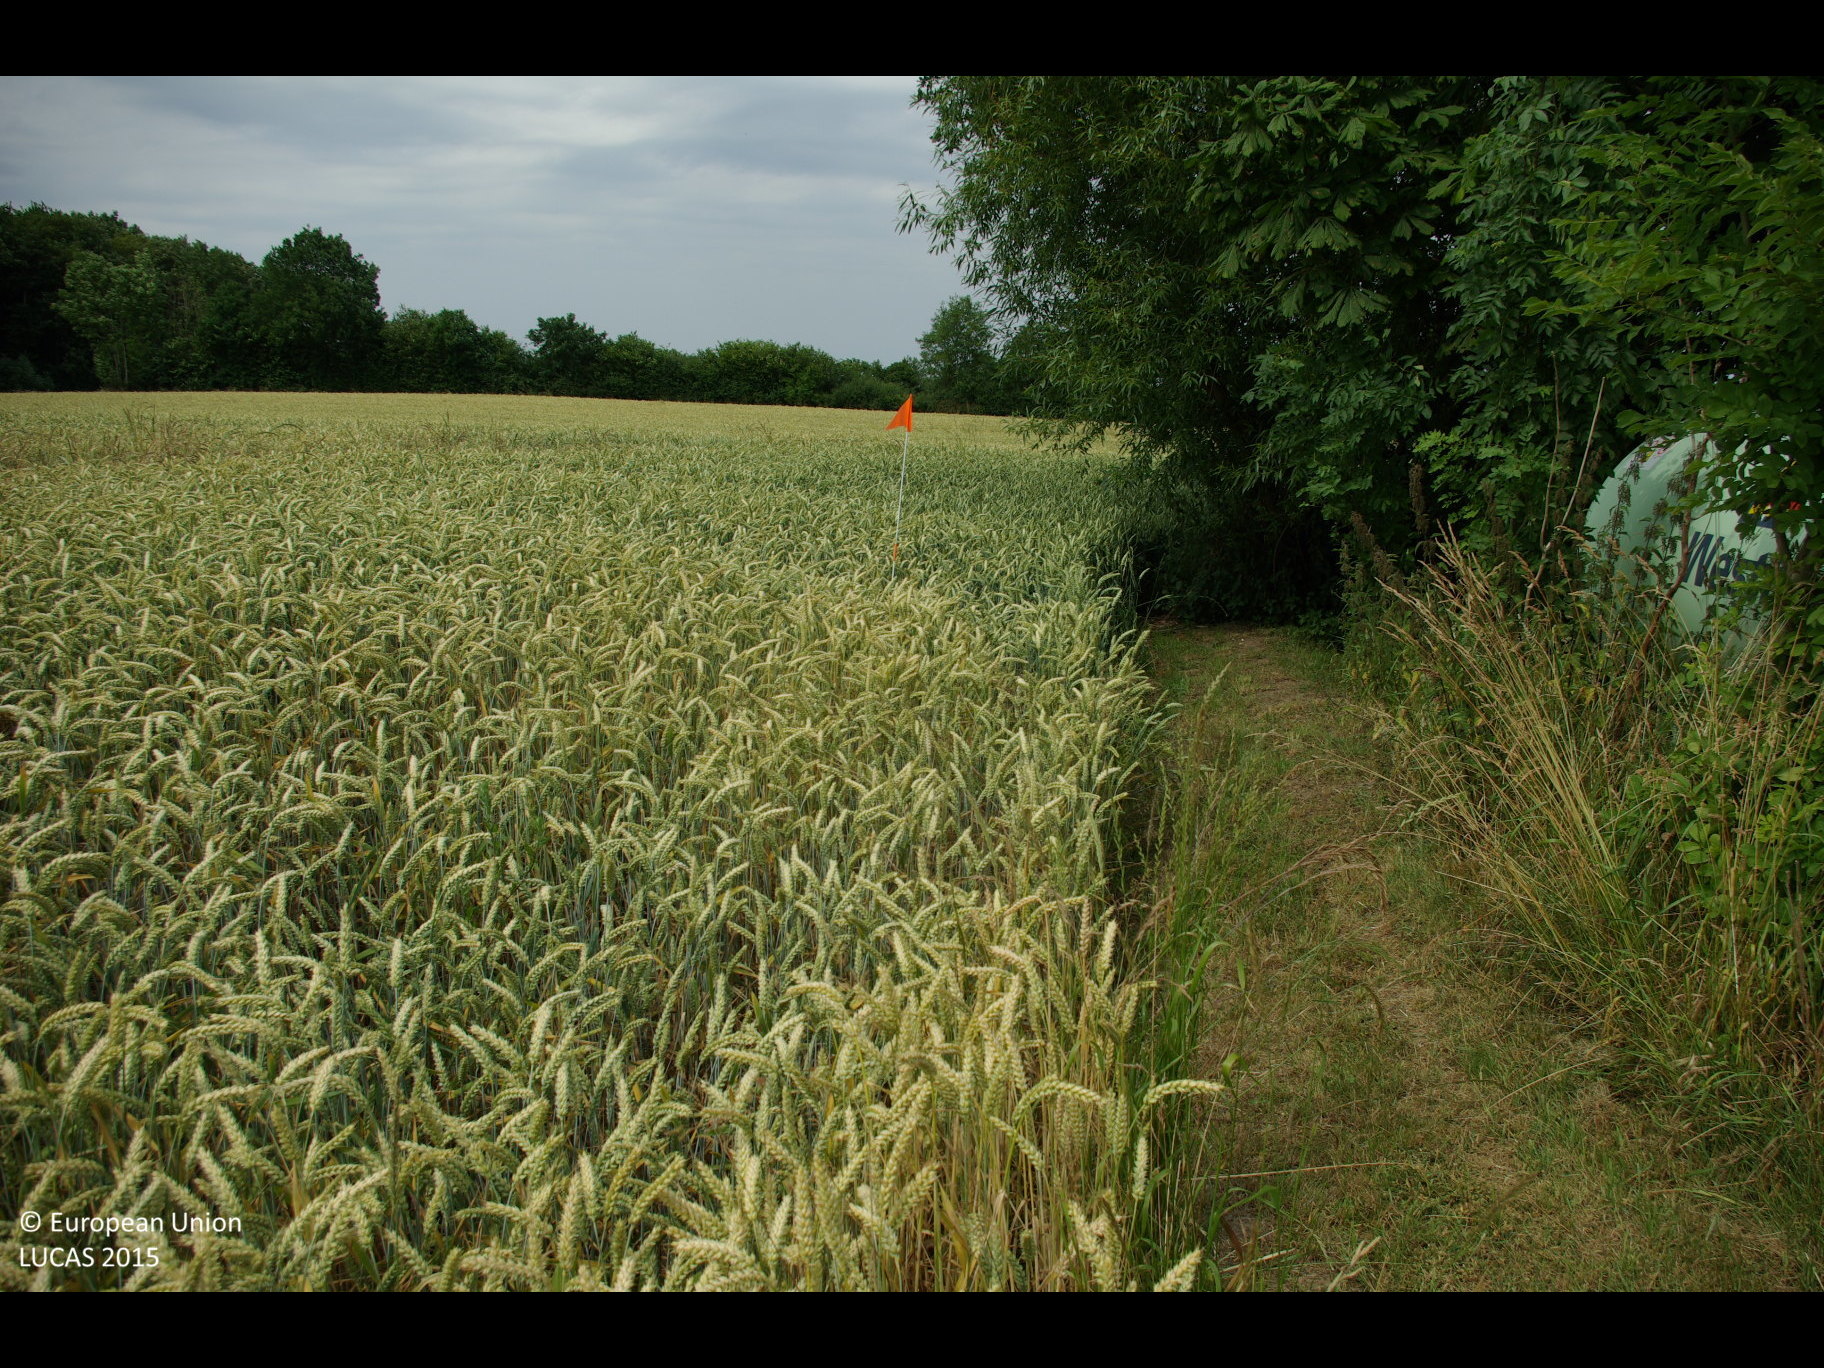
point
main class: Cropland
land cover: Common wheat
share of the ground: > 75 %
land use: Agriculture (excluding fallow land and kitchen gardens)
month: July
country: DE
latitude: 54.7139
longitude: 9.9224
